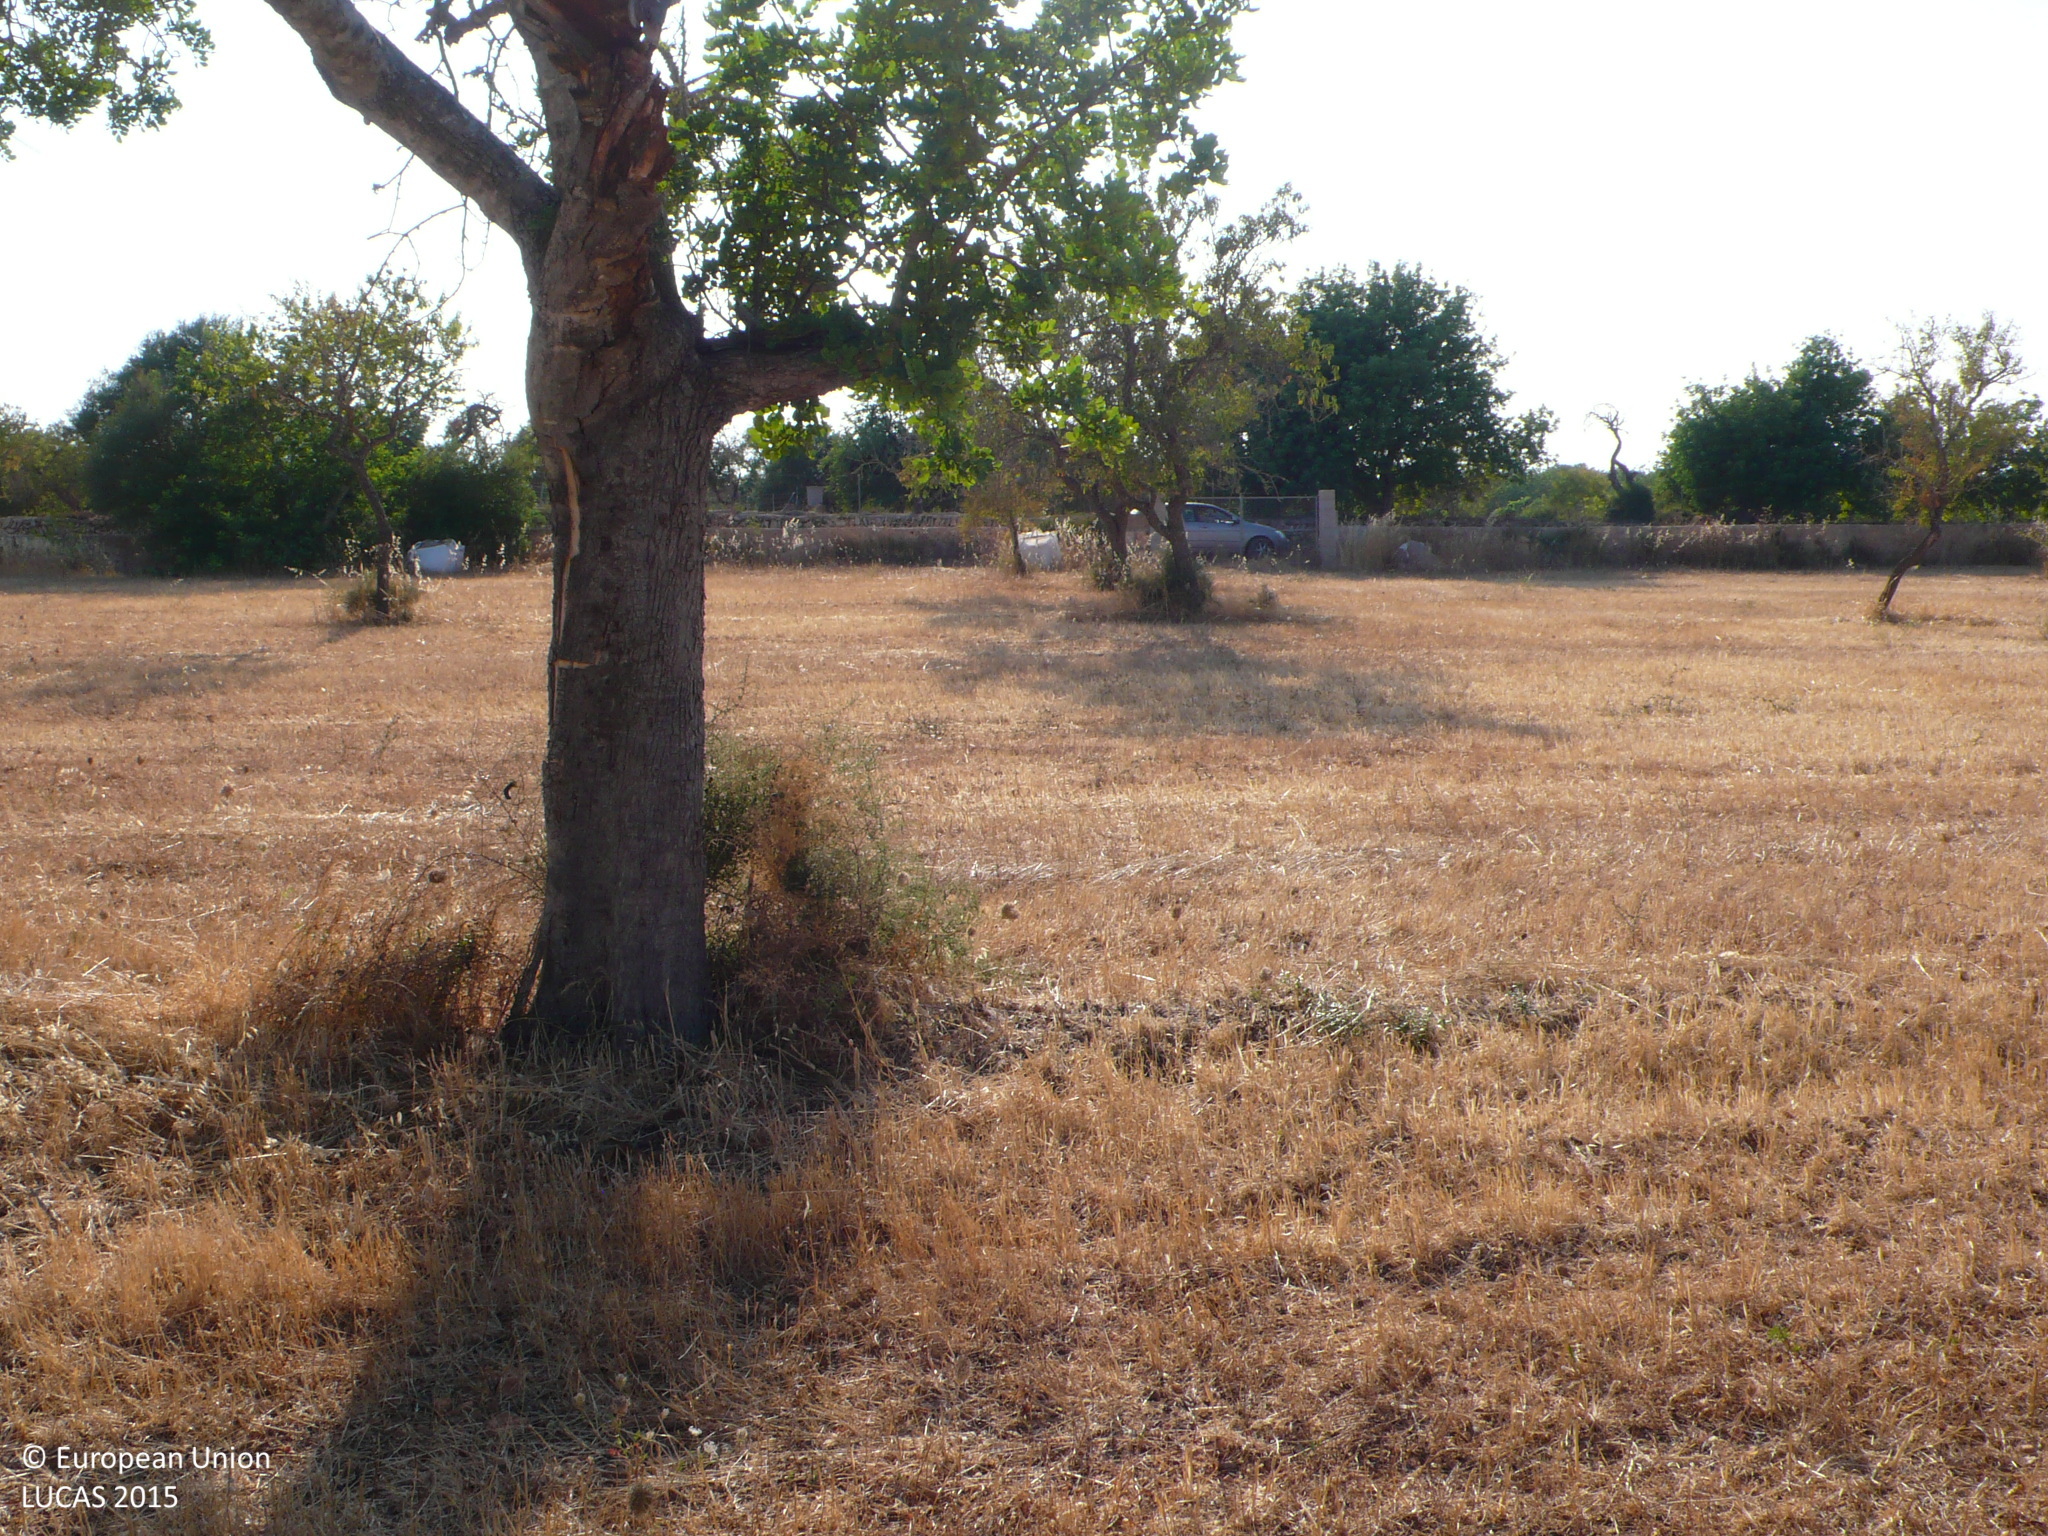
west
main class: Cropland
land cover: Permanent industrial crops
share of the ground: 10 - 25 %
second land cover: Spontaneously vegetated surfaces
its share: > 75 %
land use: Agriculture (excluding fallow land and kitchen gardens)
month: July
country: ES
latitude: 39.4636
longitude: 2.8830
